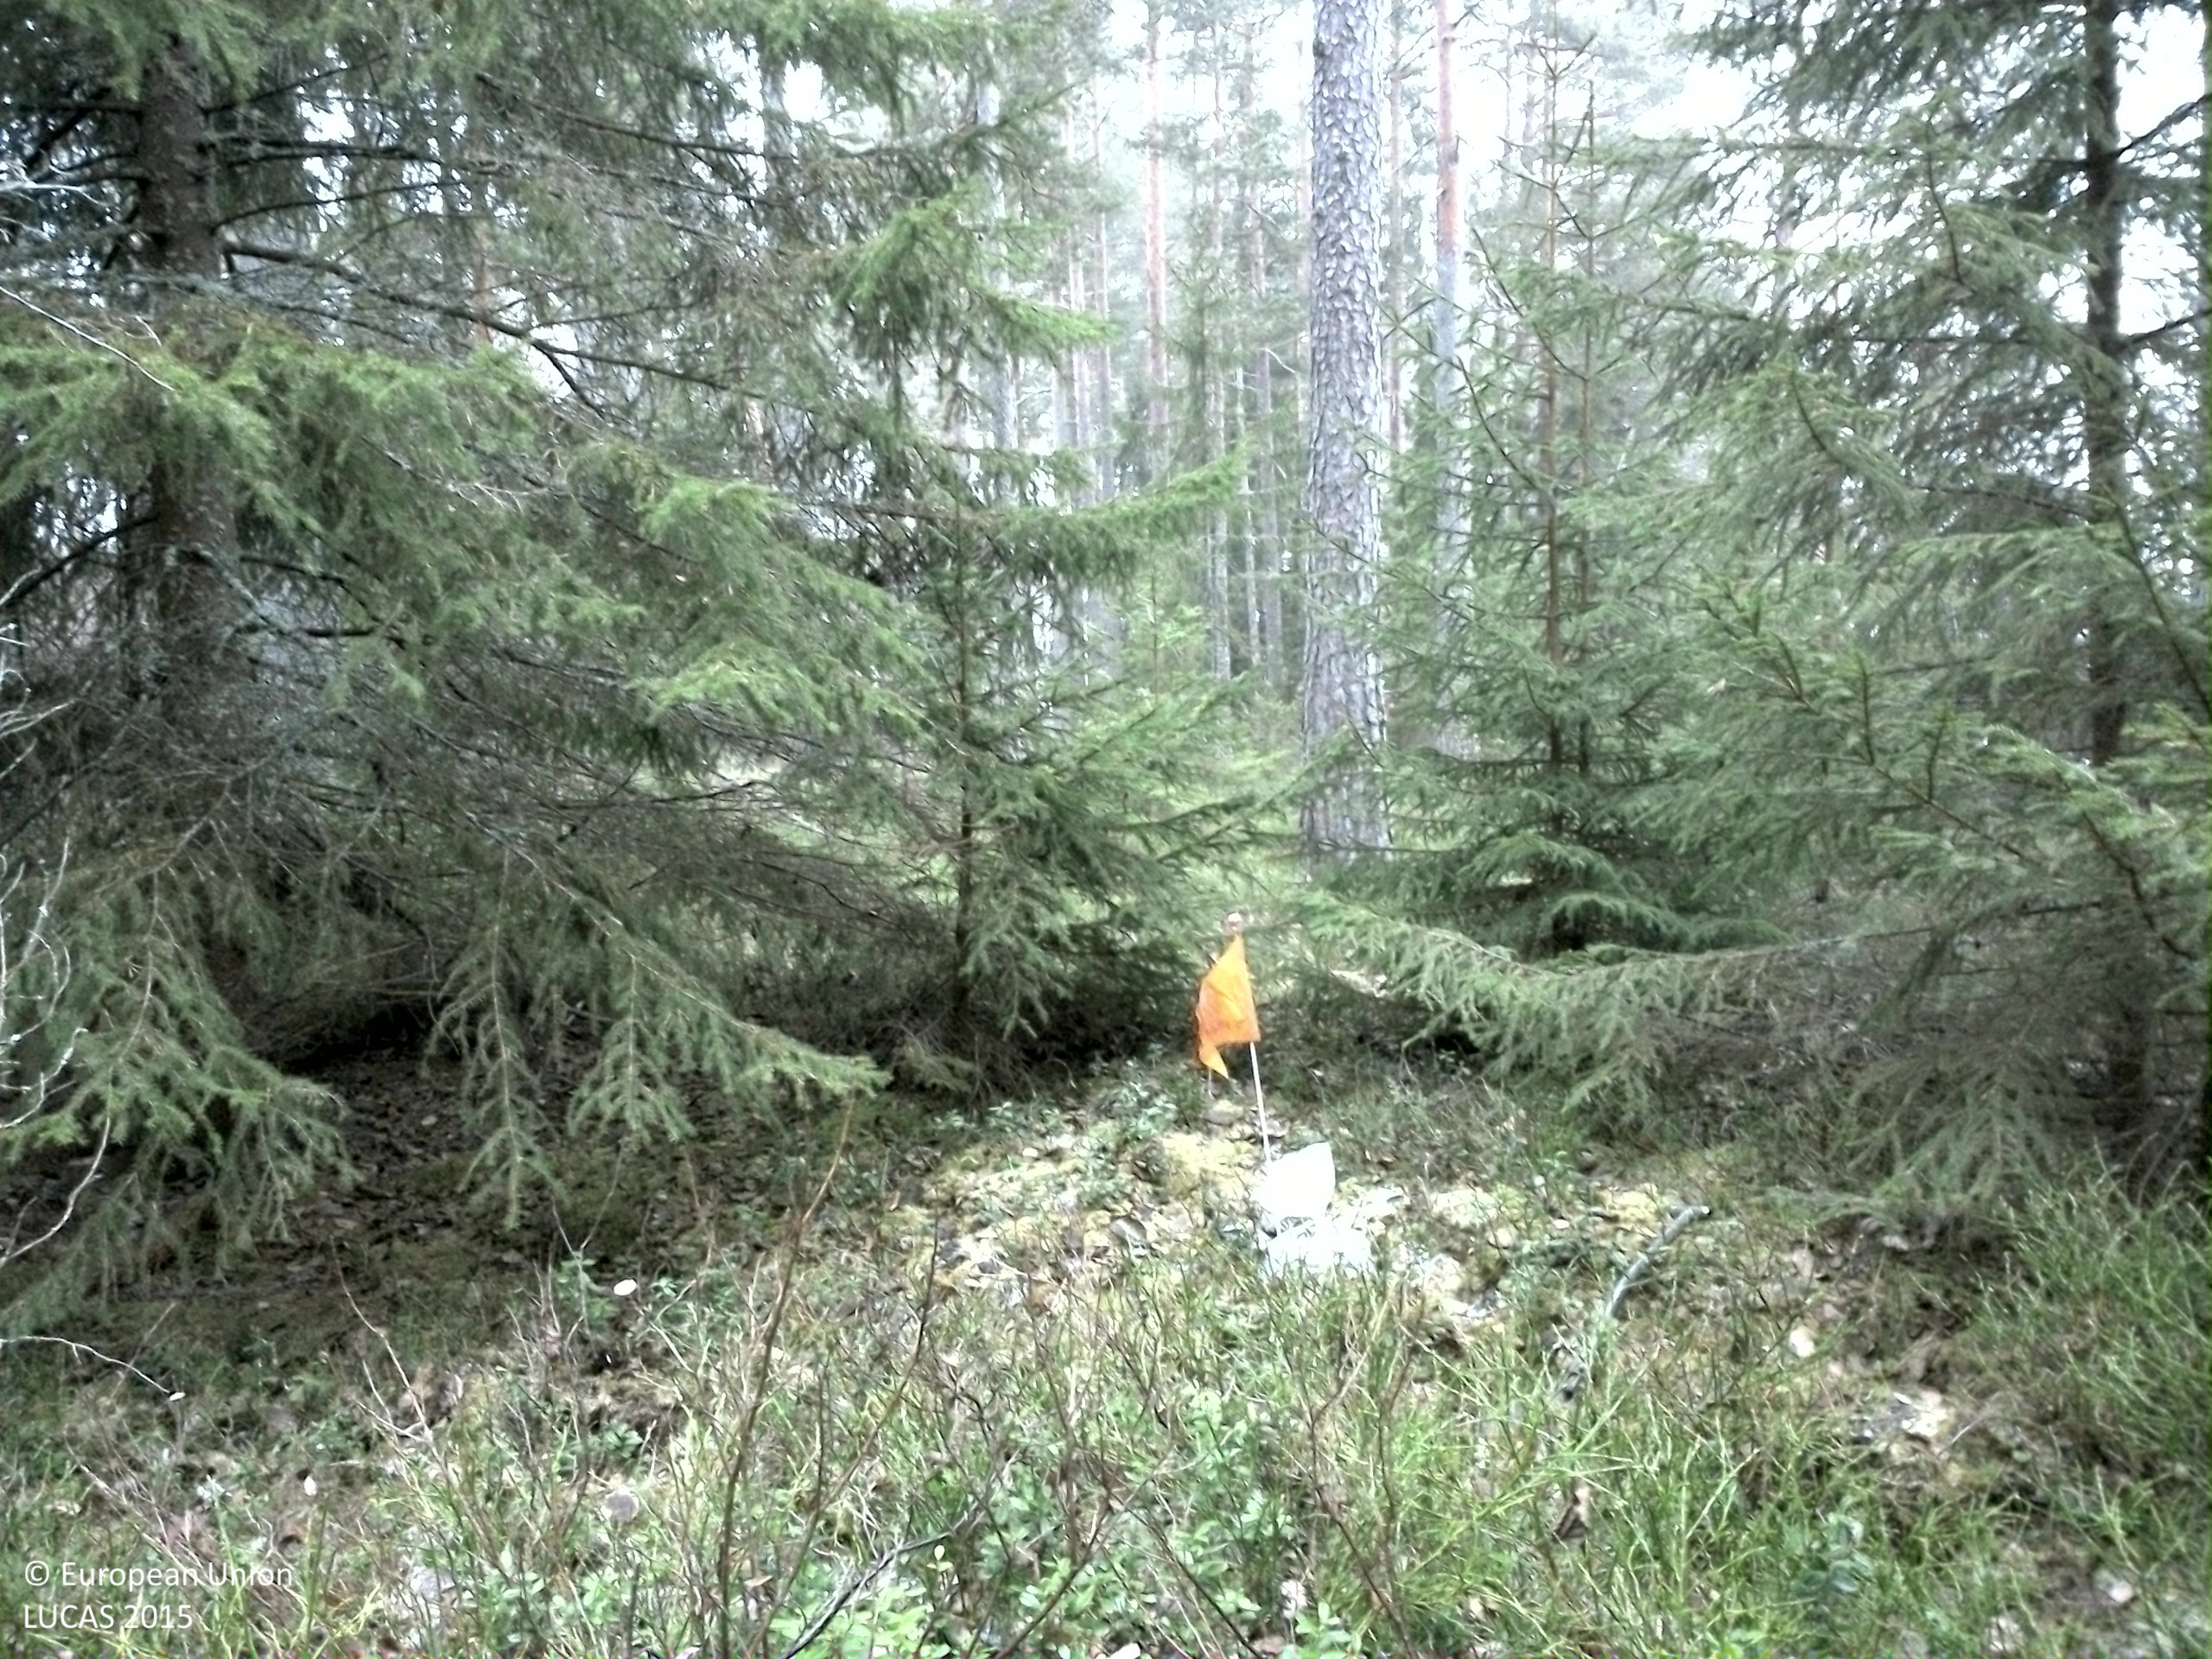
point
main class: Woodland
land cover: Other coniferous woodland
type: boreal forest
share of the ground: 50 - 75 %
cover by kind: coniferous forest trees 60 %, shrubs 25 %, lichens and mosses 10 %, broadleaved forest trees 5 %
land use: Forestry
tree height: > 5 m
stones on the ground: < 10 %
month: November
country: SE
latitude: 60.3513
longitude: 16.6041
